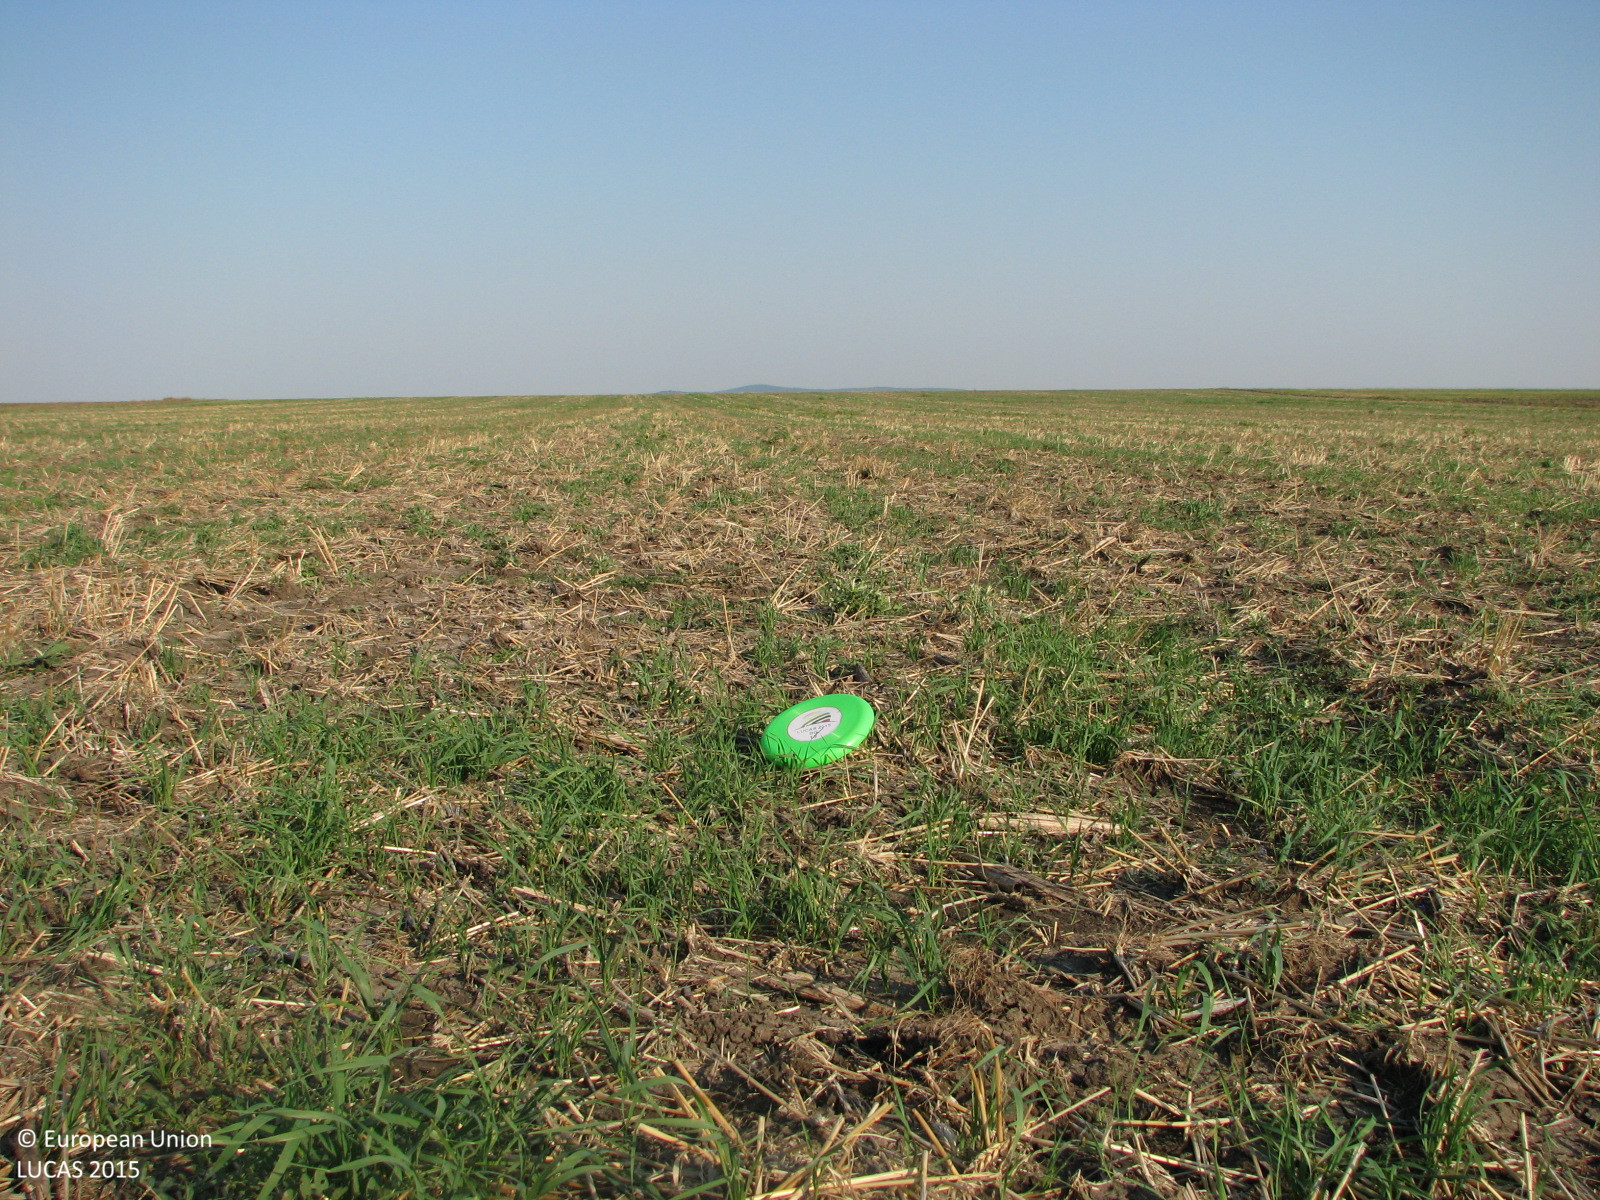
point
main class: Cropland
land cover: Common wheat
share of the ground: 25 - 50 %
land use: Agriculture (excluding fallow land and kitchen gardens)
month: September
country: BG
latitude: 42.3342
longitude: 26.6354
